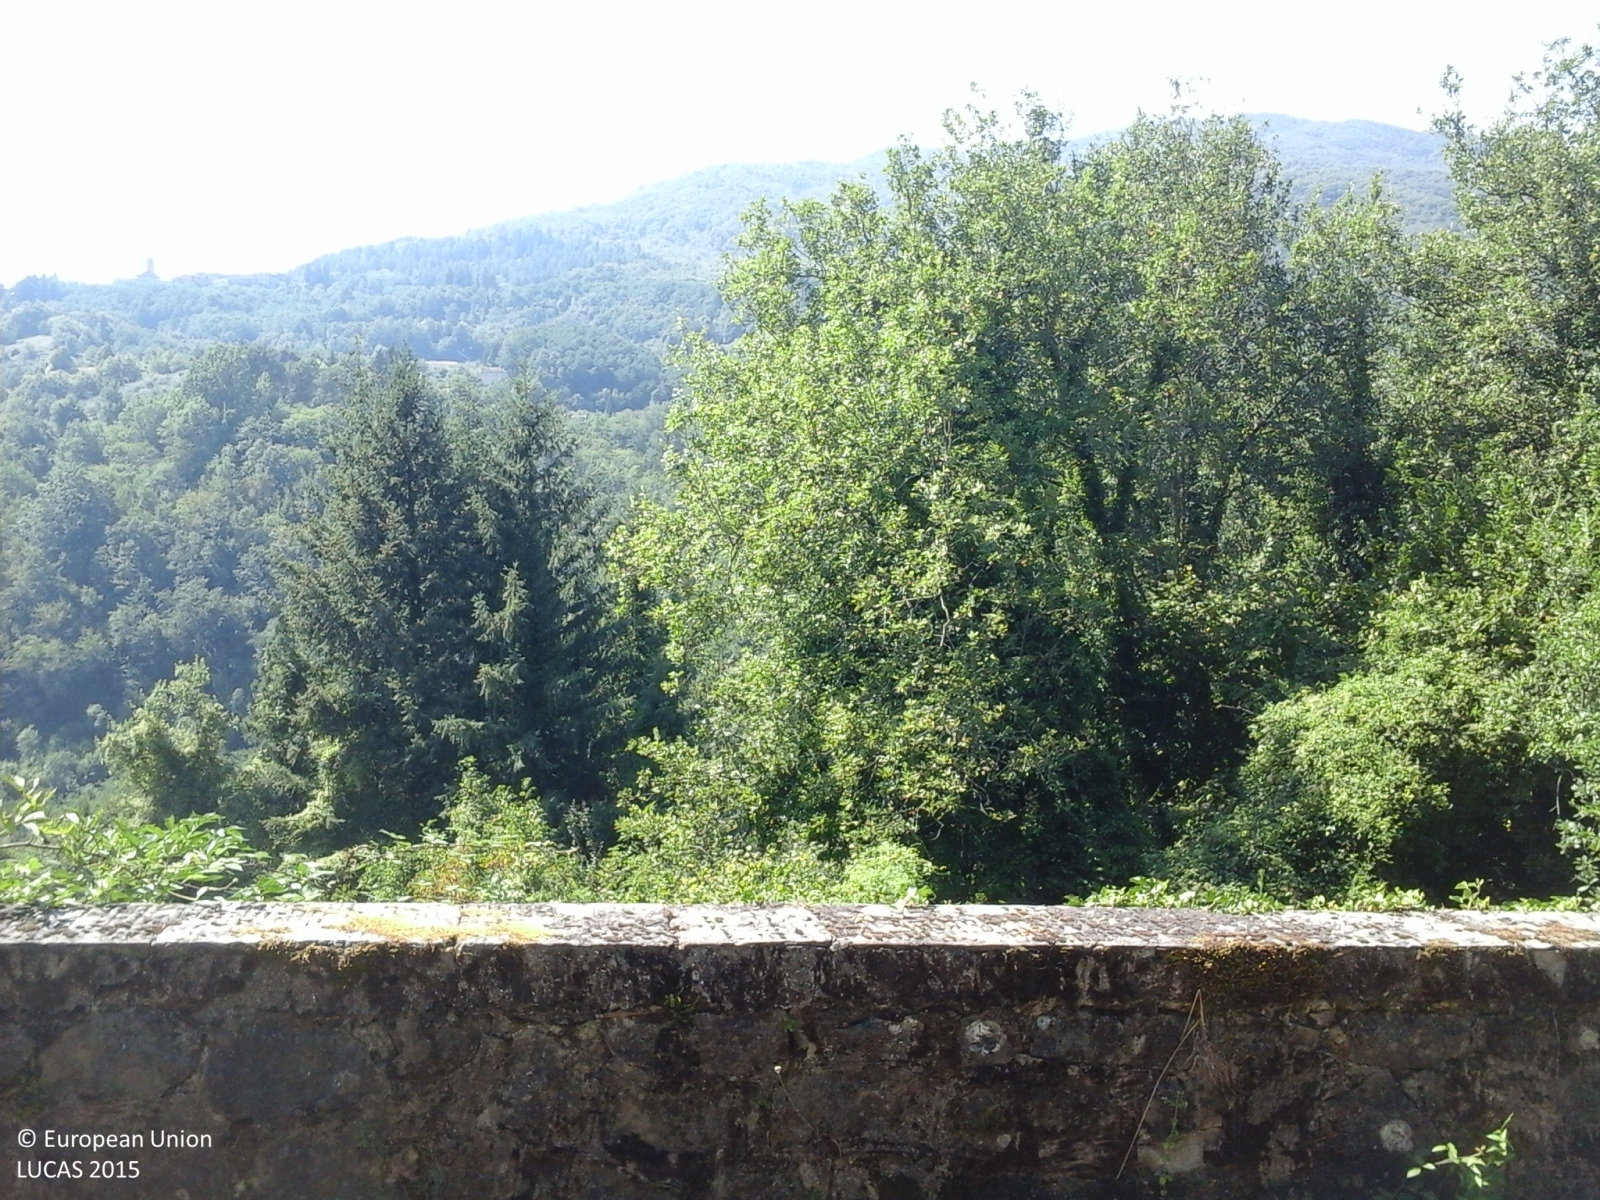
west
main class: Woodland
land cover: Broadleaved woodland
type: thermophilous deciduous forest
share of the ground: > 75 %
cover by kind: broadleaved forest trees 100 %
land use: Forestry
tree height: > 5 m
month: August
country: IT
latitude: 43.9693
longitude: 10.7087
